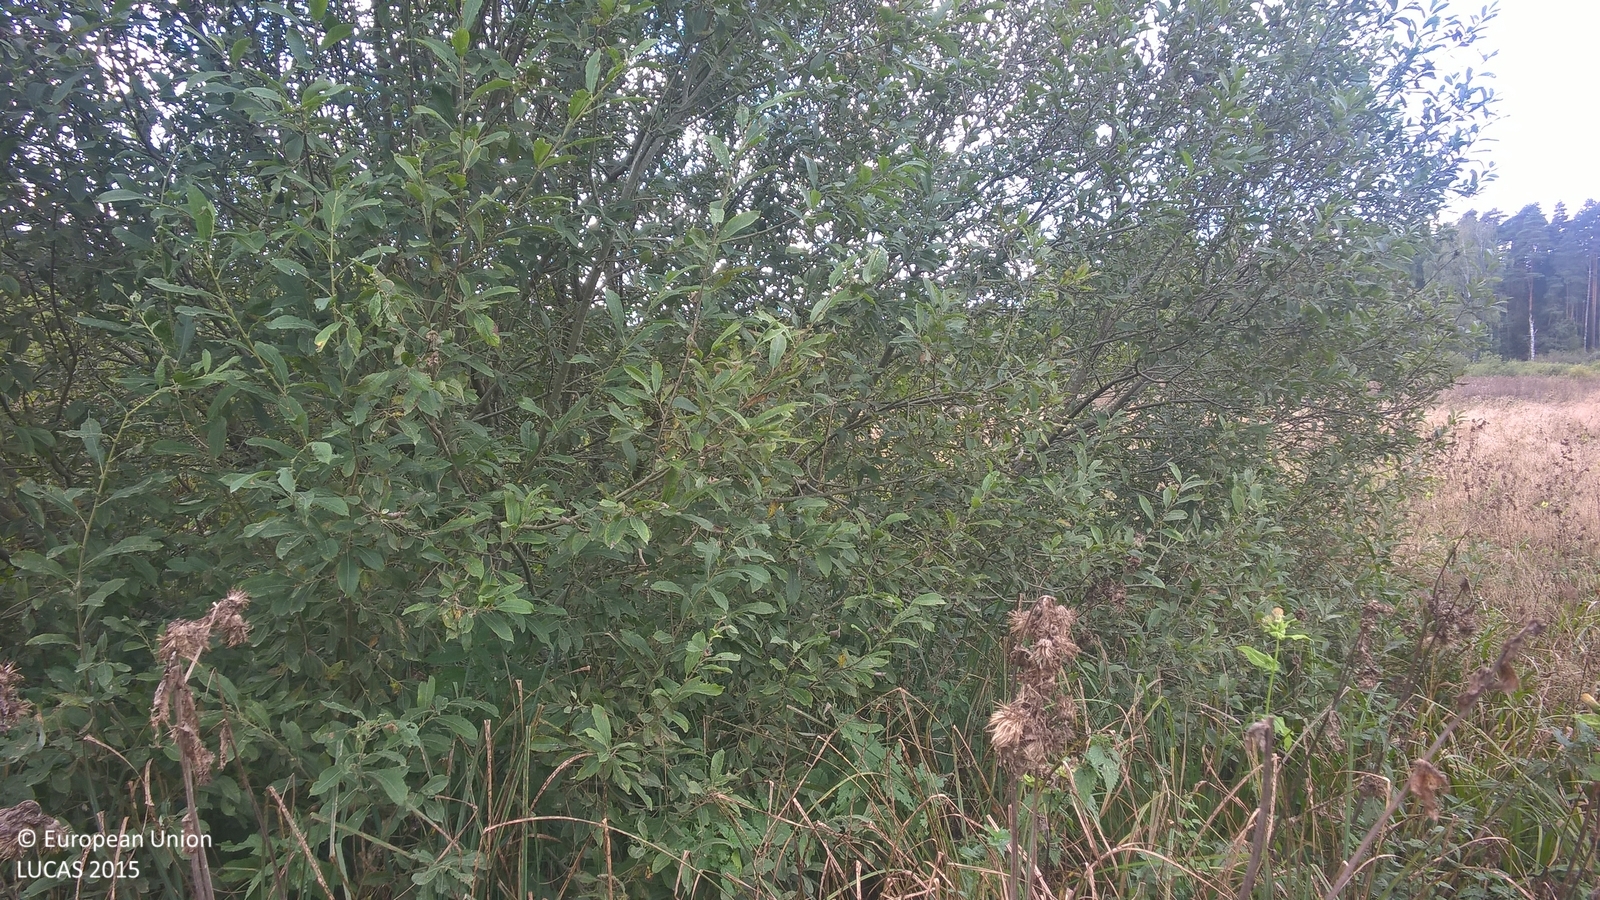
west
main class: Grassland
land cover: Spontaneously vegetated surfaces
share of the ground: > 75 %
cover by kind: herbaceous plants 95 %, shrubs 5 %
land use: Semi-natural and natural areas not in use
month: September
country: LV
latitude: 57.7172
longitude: 25.6456
